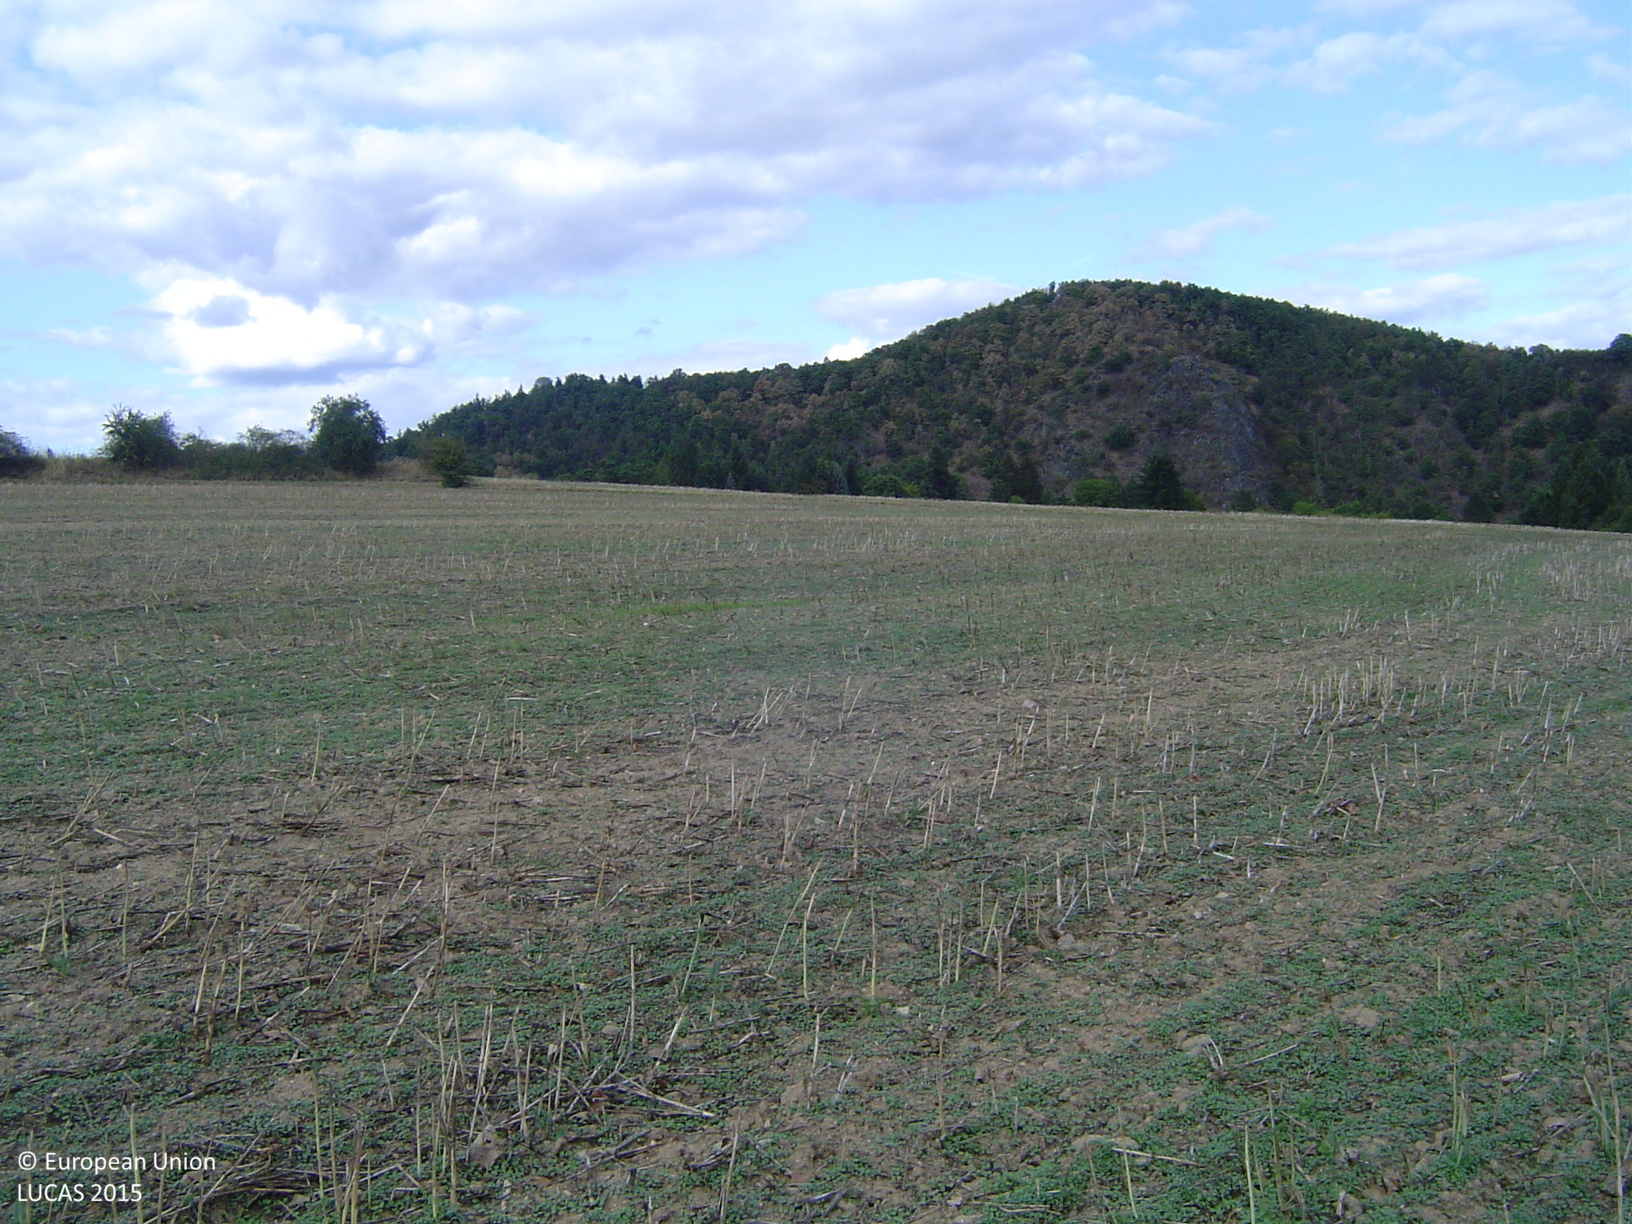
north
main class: Cropland
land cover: Rape and turnip rape
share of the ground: < 10 %
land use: Agriculture (excluding fallow land and kitchen gardens)
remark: Harvested field
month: August
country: CZ
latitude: 49.7065
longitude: 14.3138
